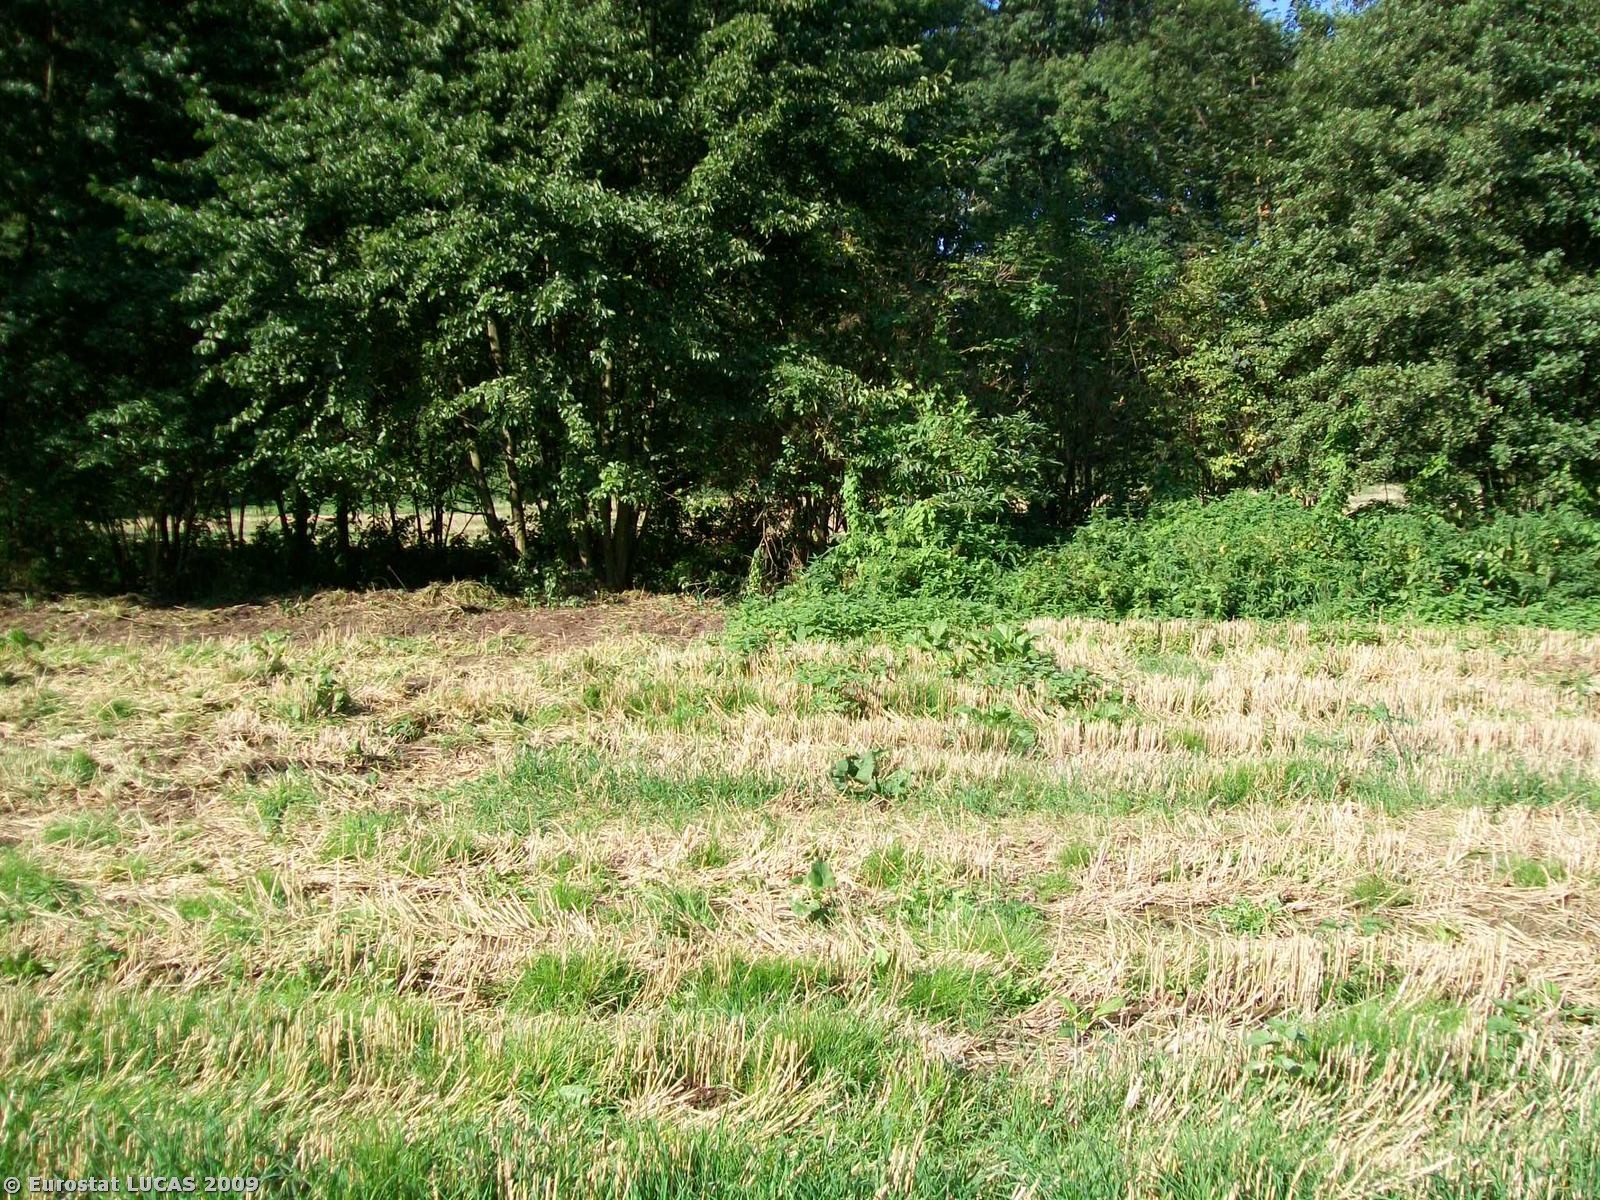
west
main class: Cropland
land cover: Common wheat
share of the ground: < 10 %
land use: Agriculture (excluding fallow land and kitchen gardens)
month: September
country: PL
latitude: 50.5151
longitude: 17.2176
